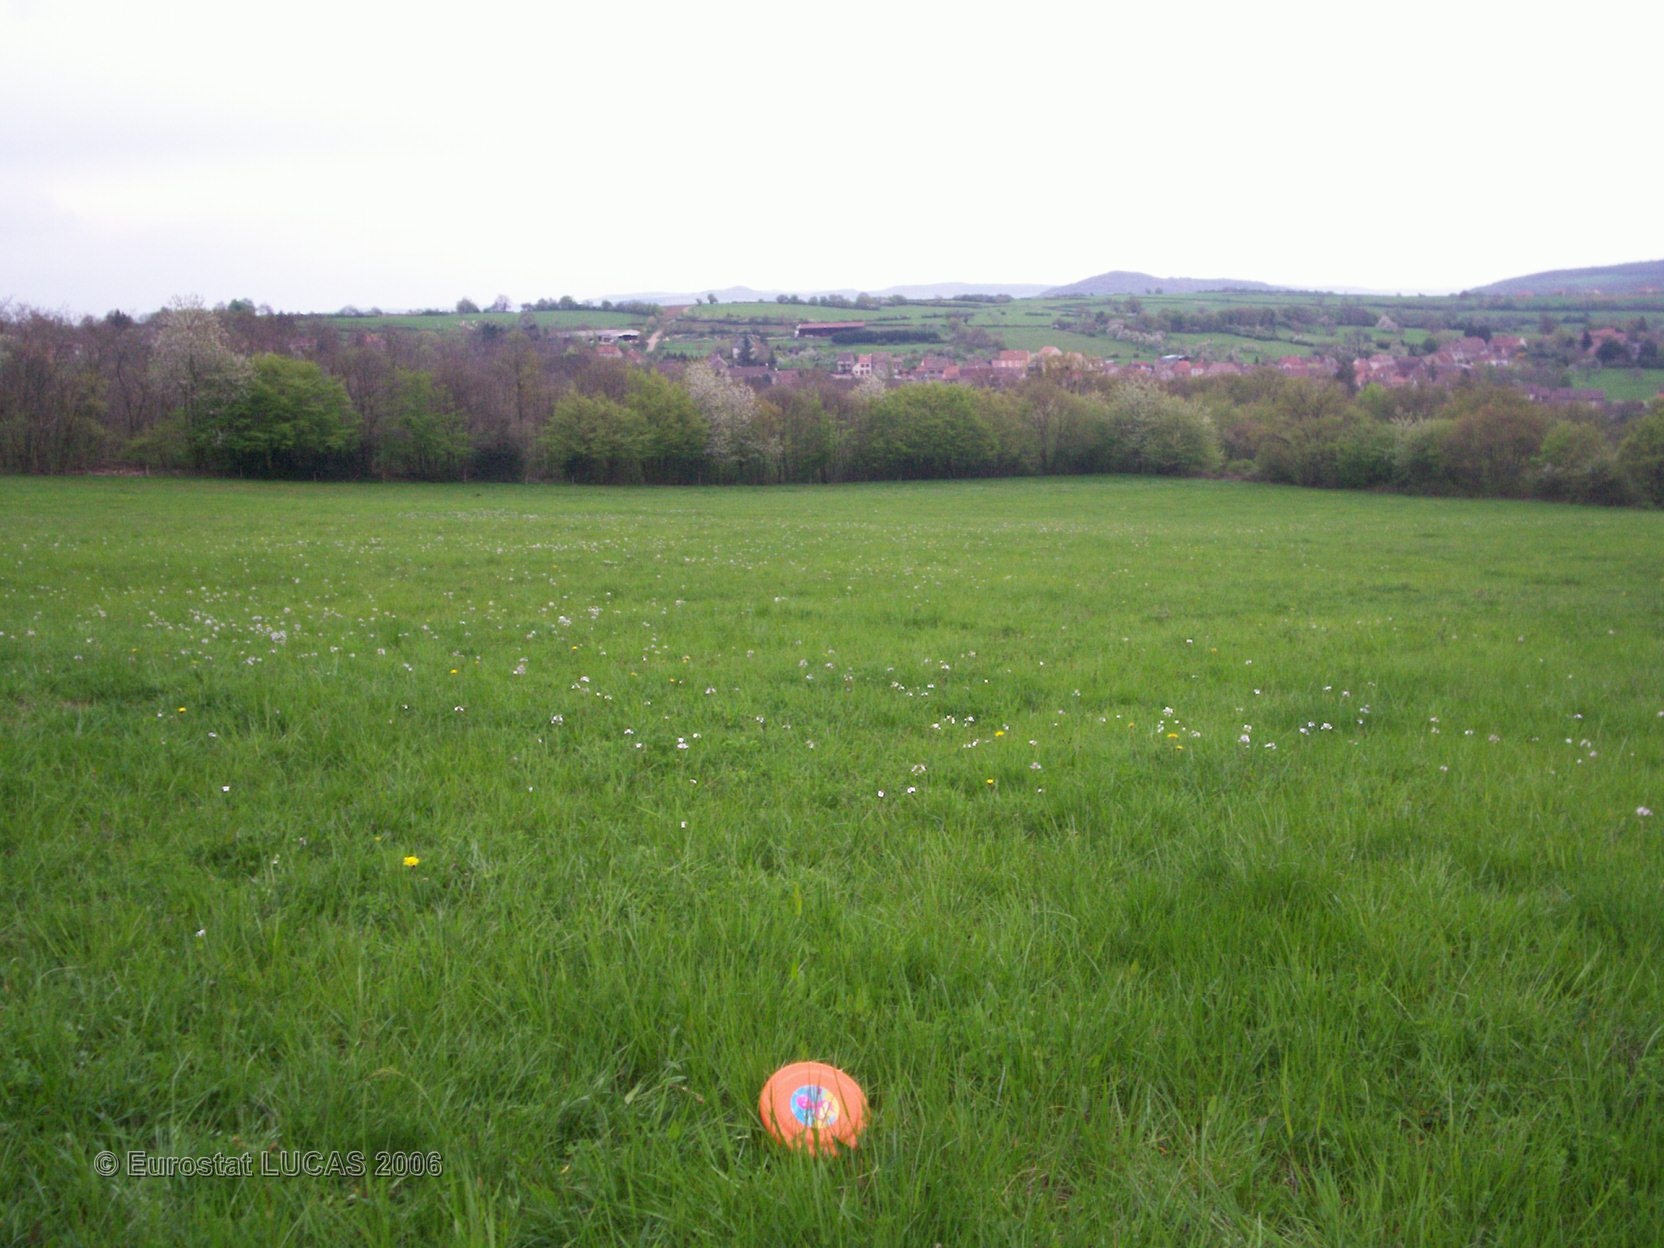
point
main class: Grassland
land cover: Grassland without tree/shrub cover
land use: Agriculture (excluding fallow land and kitchen gardens)
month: April
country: FR
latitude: 46.8317
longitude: 4.6651
